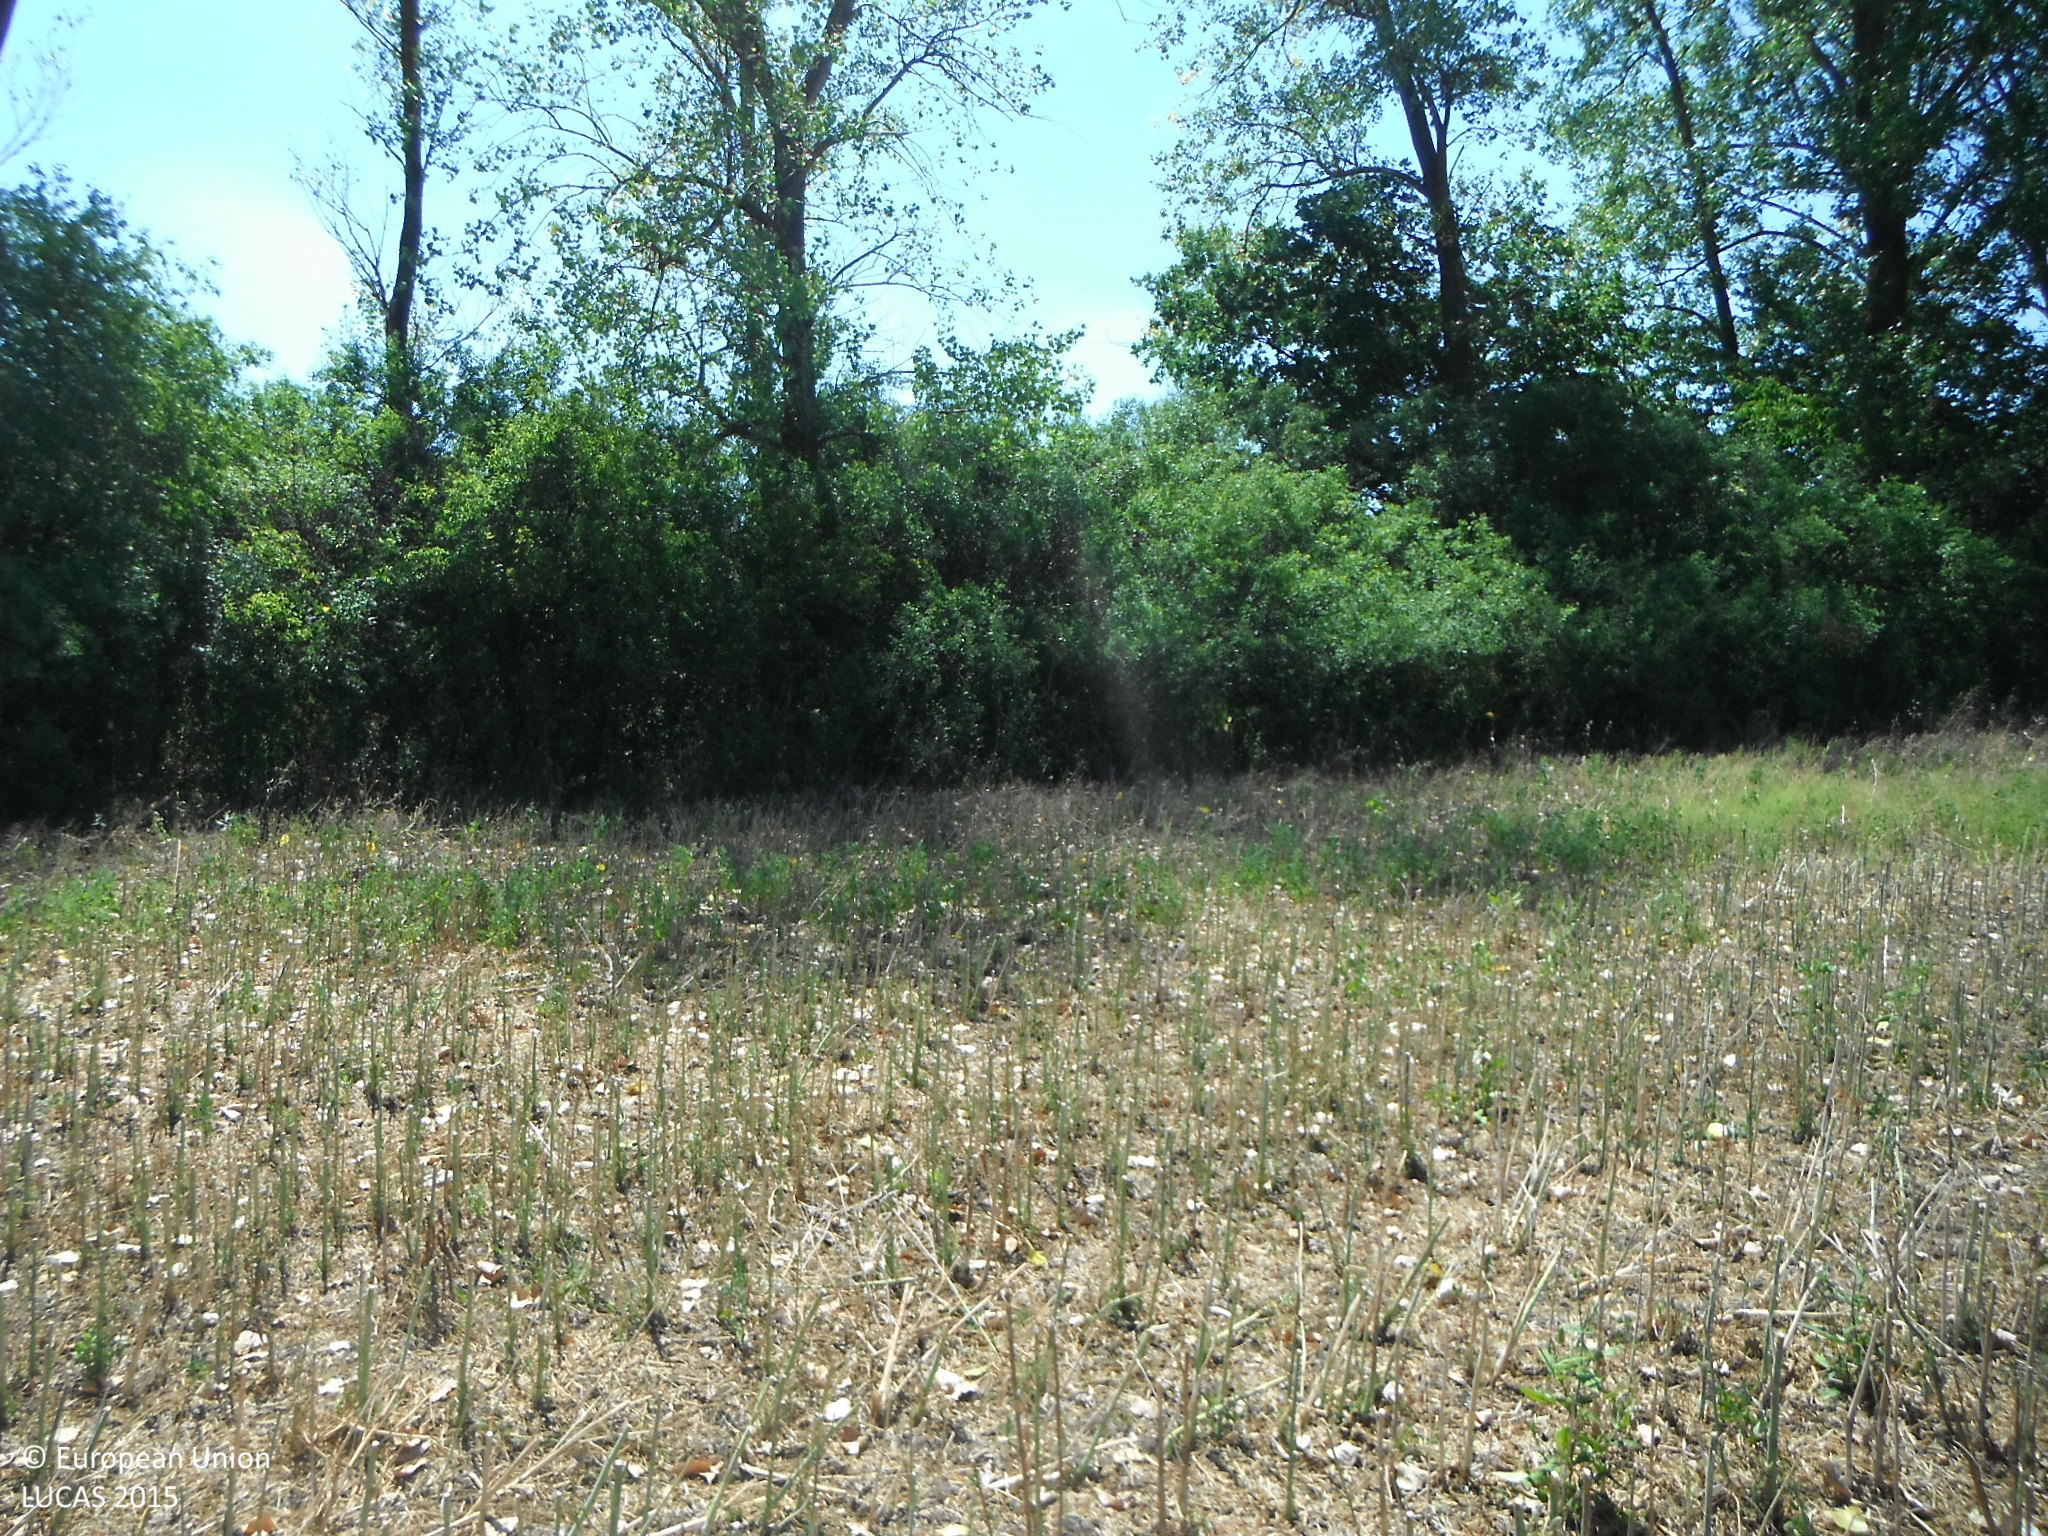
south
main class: Cropland
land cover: Rape and turnip rape
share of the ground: 10 - 25 %
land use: Agriculture (excluding fallow land and kitchen gardens)
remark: Harvested field
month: July
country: SK
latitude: 48.5982
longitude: 21.6980
